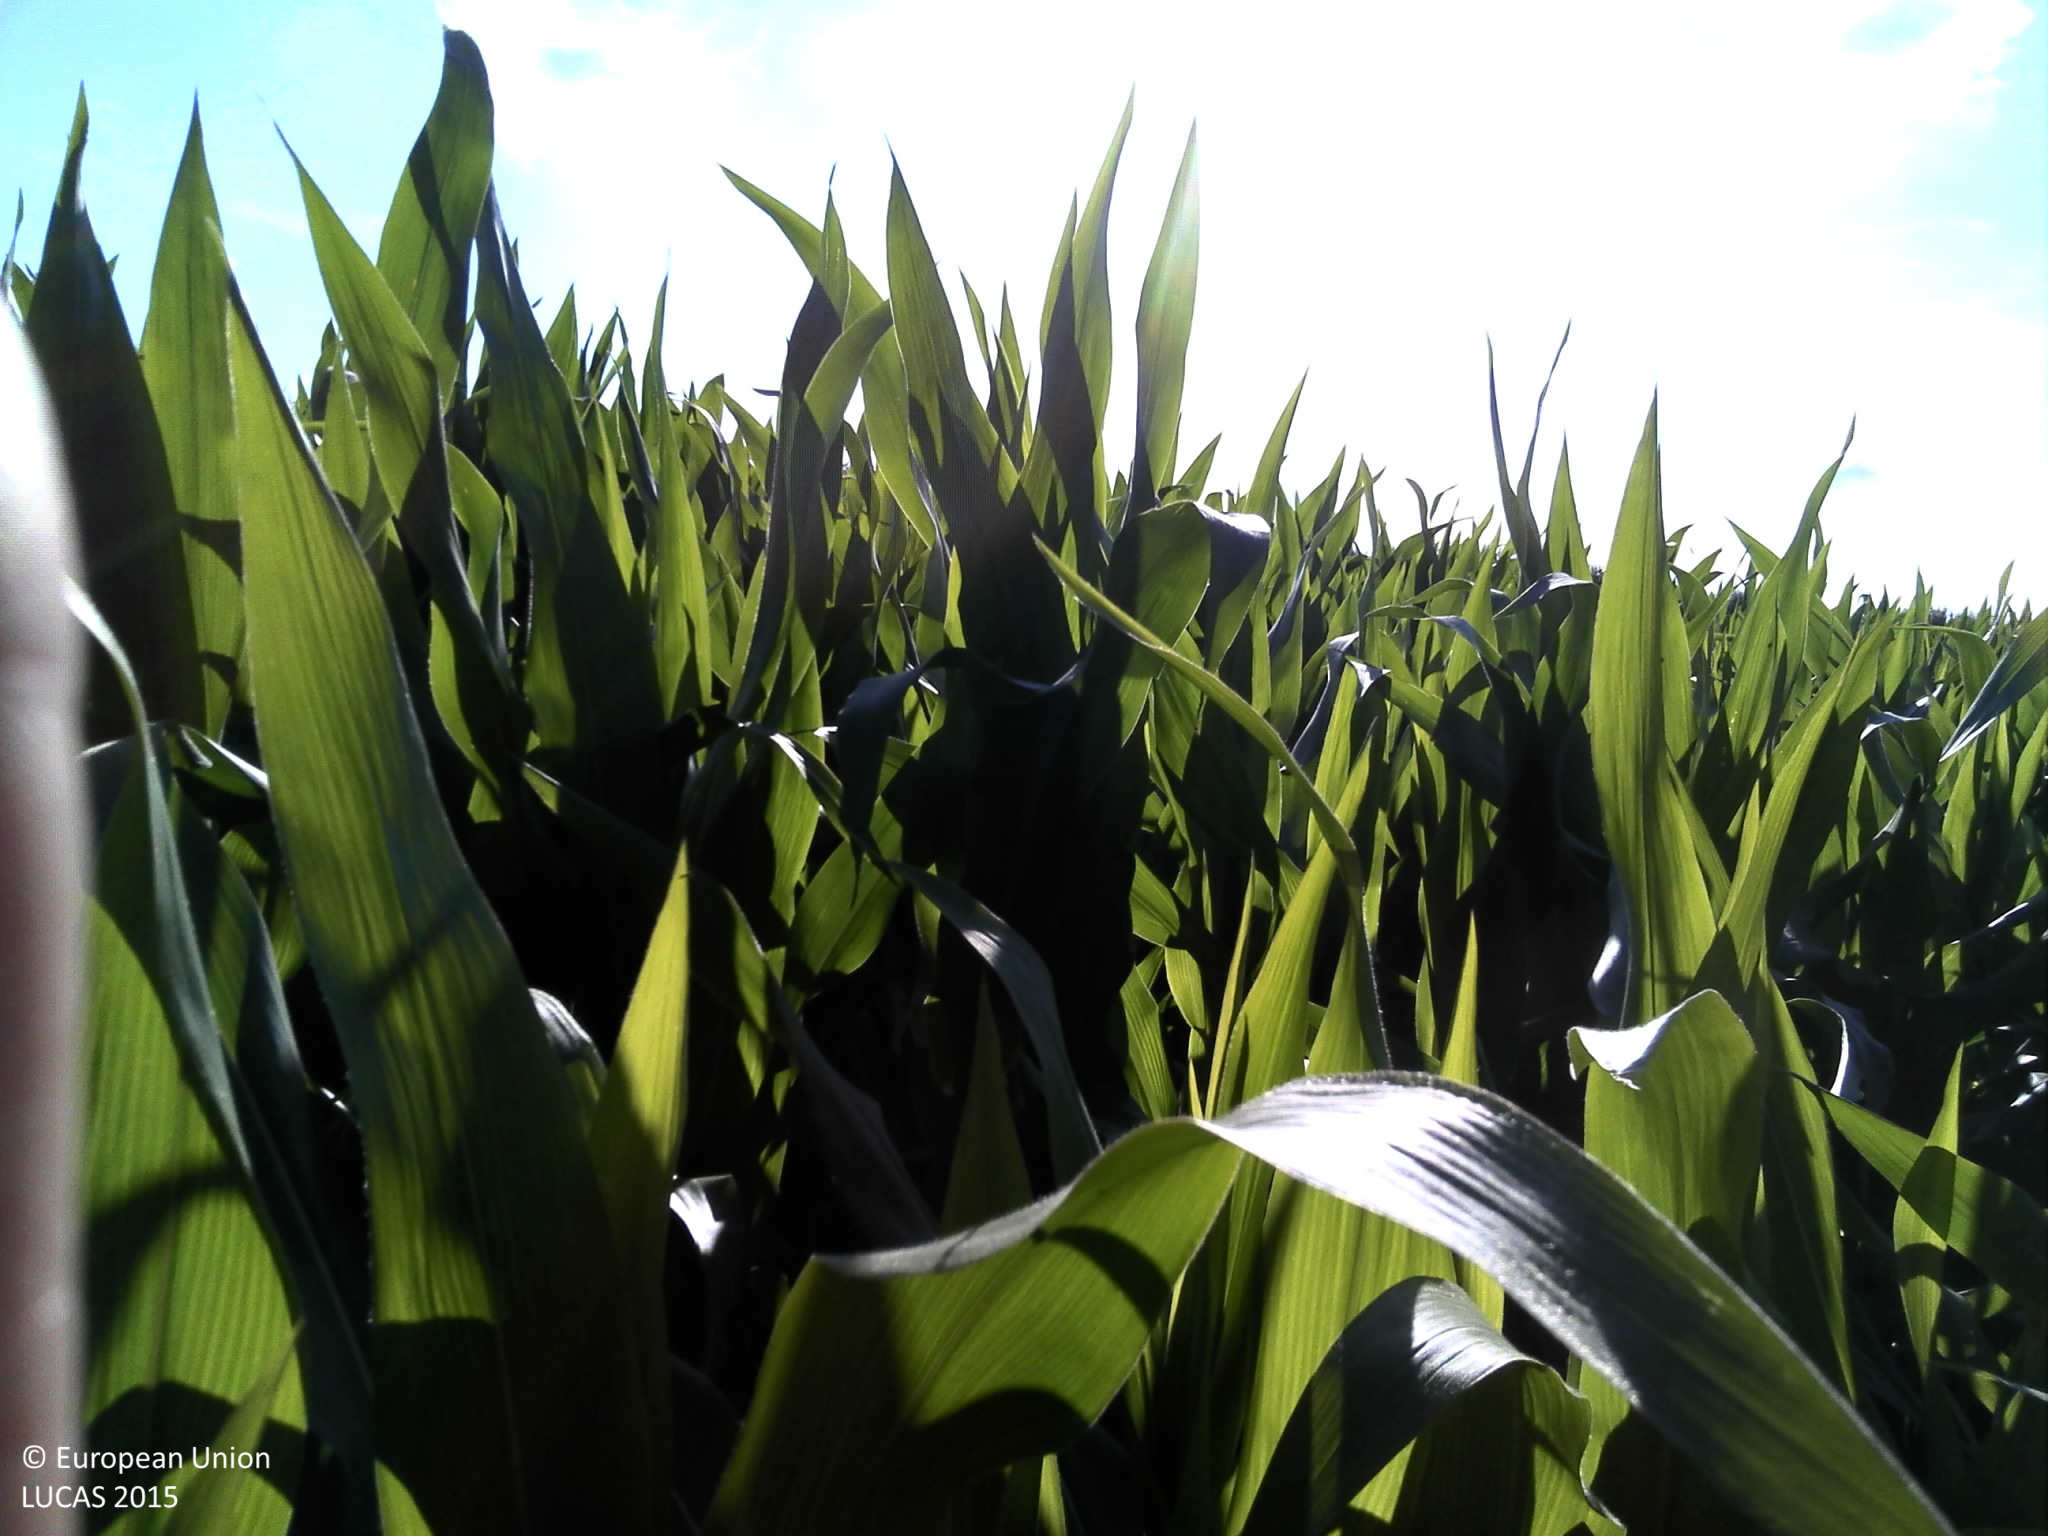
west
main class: Cropland
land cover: Maize
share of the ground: > 75 %
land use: Agriculture (excluding fallow land and kitchen gardens)
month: July
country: FR
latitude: 48.5384
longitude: -4.4964
